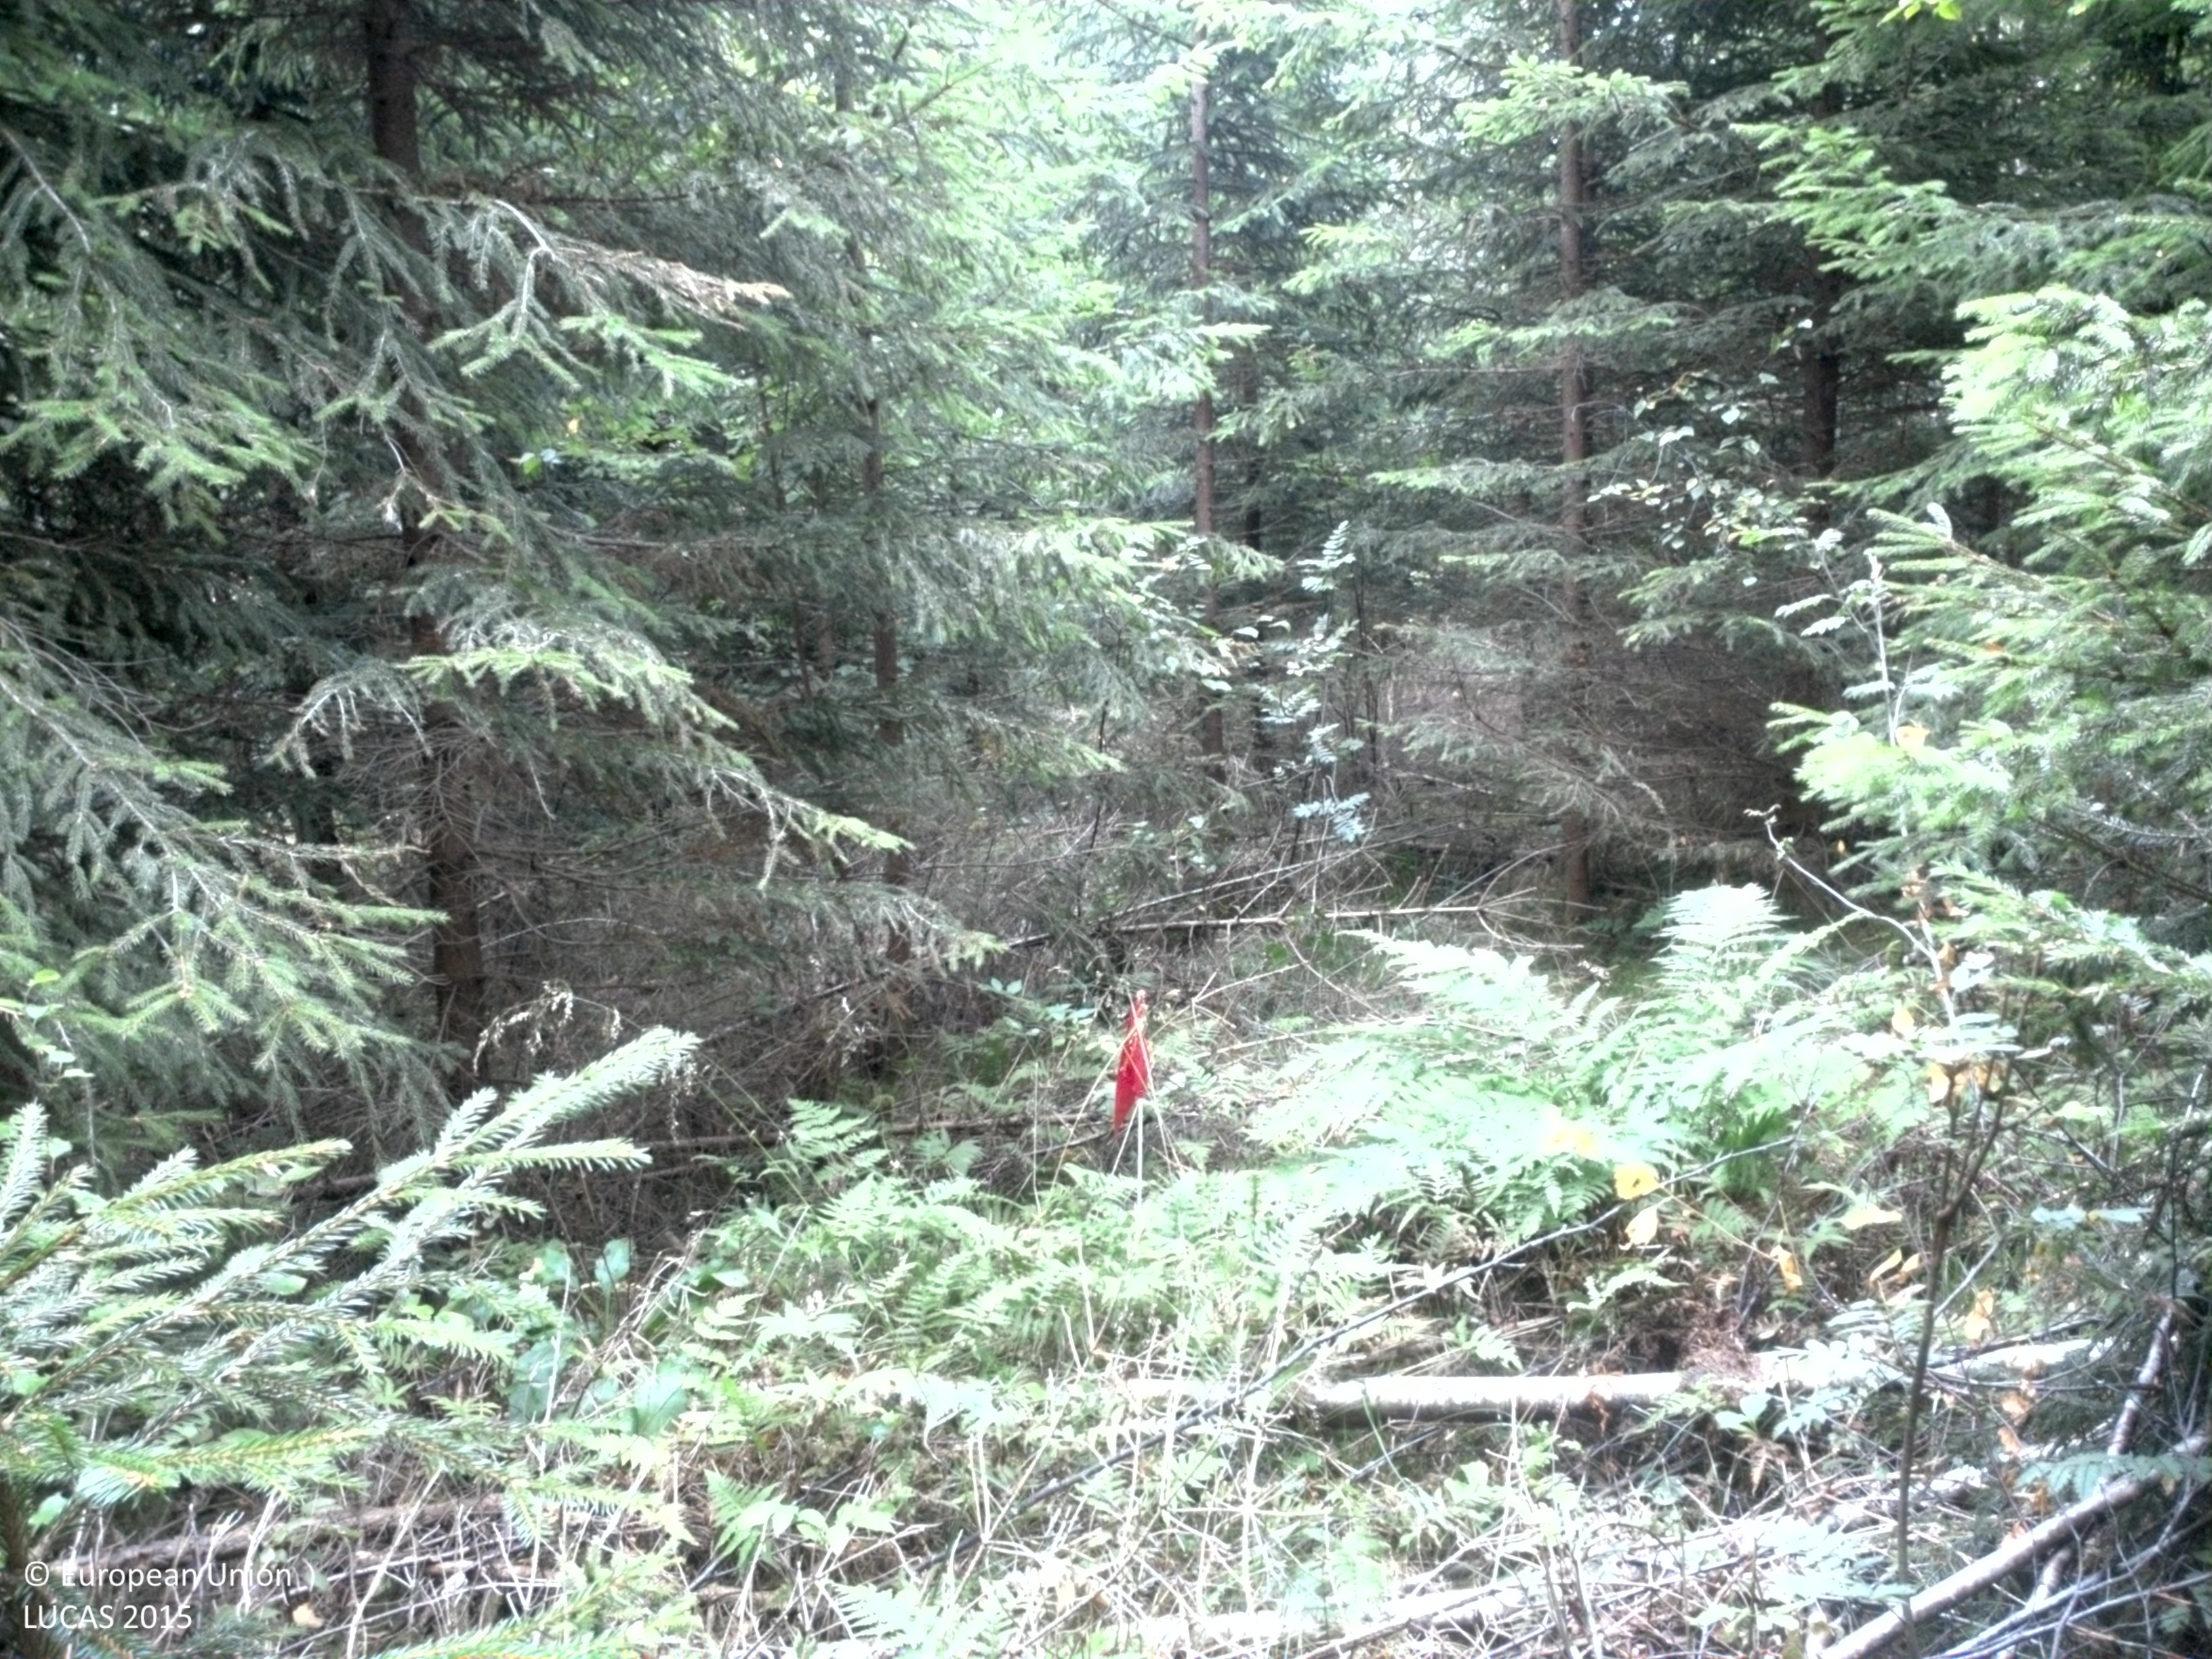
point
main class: Woodland
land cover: Spruce dominated mixed woodland
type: boreal forest
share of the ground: 50 - 75 %
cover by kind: coniferous forest trees 50 %, broadleaved forest trees 20 %, herbaceous plants 20 %, lichens and mosses 10 %
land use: Forestry
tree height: > 5 m
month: August
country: SE
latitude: 59.5972
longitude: 13.4816
